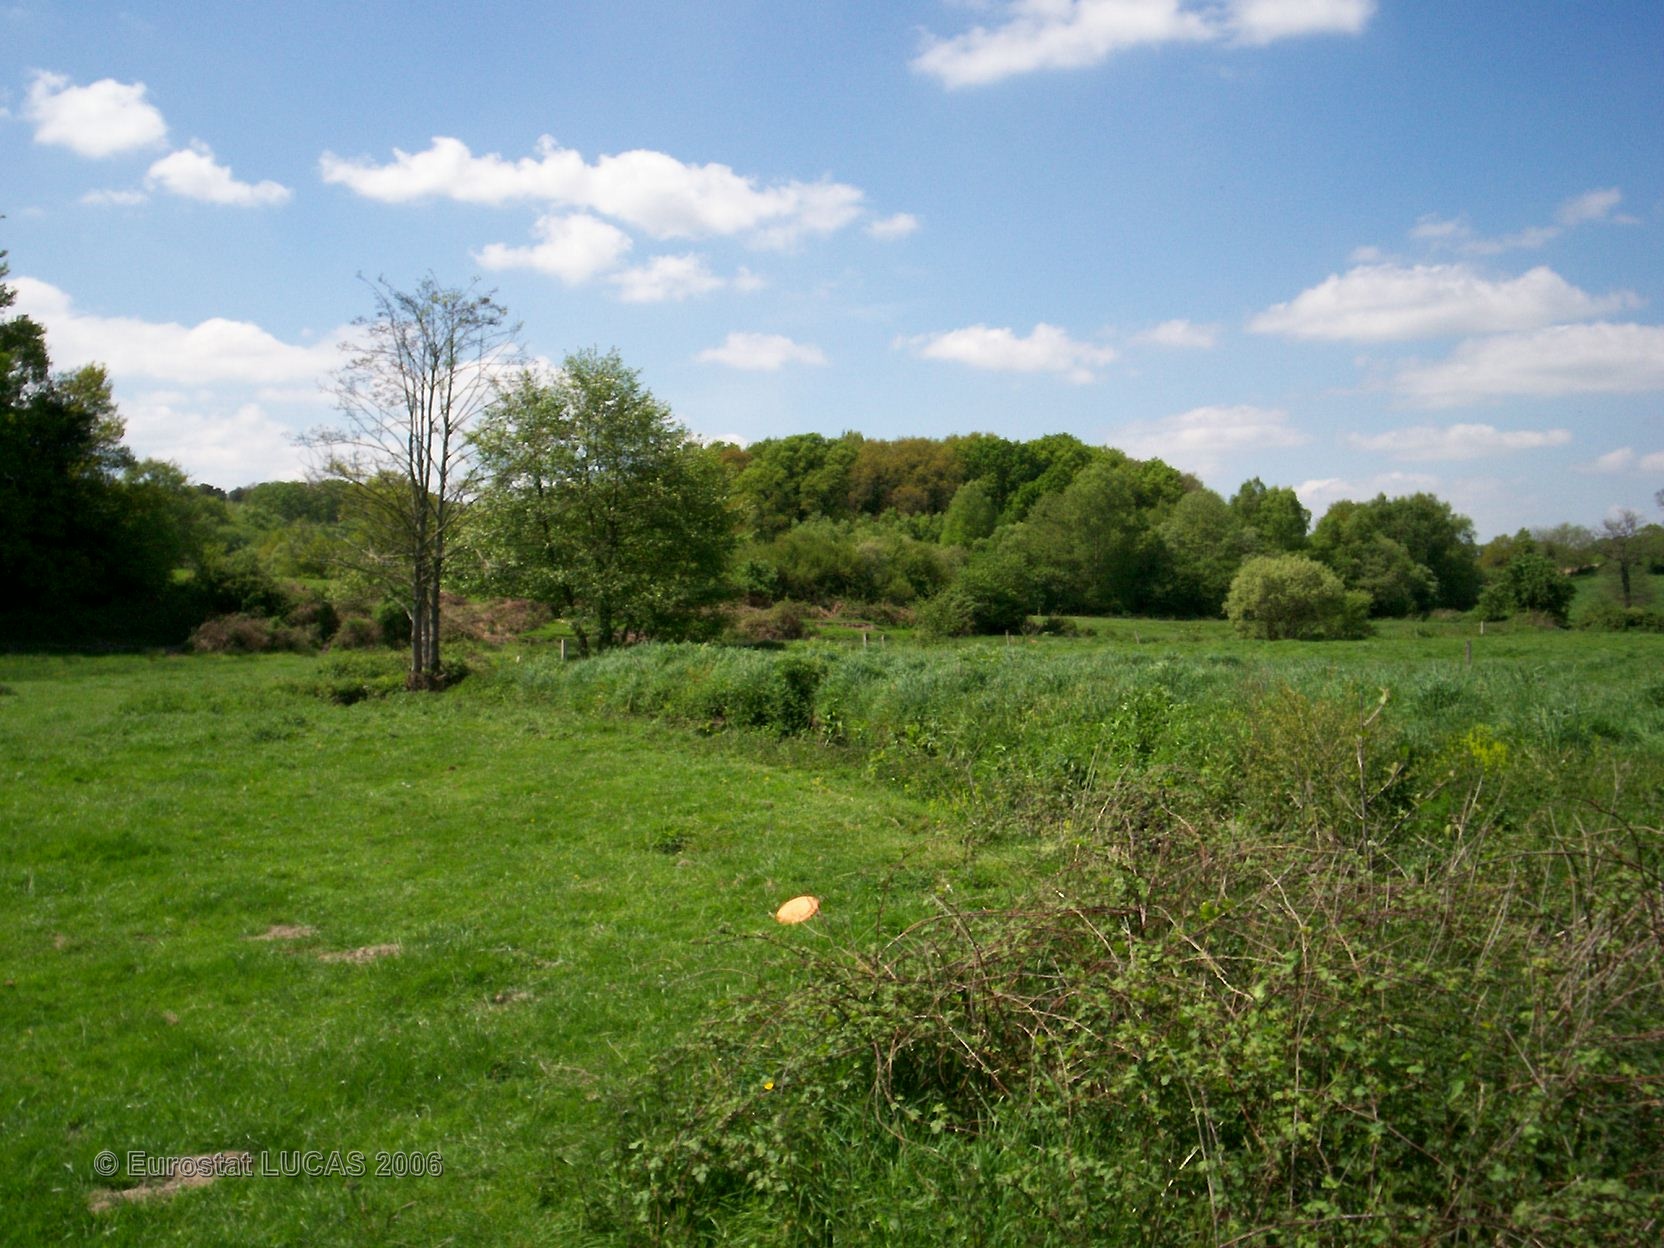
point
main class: Grassland
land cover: Grassland without tree/shrub cover
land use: Agriculture (excluding fallow land and kitchen gardens)
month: May
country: FR
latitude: 47.6099
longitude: -2.2526
